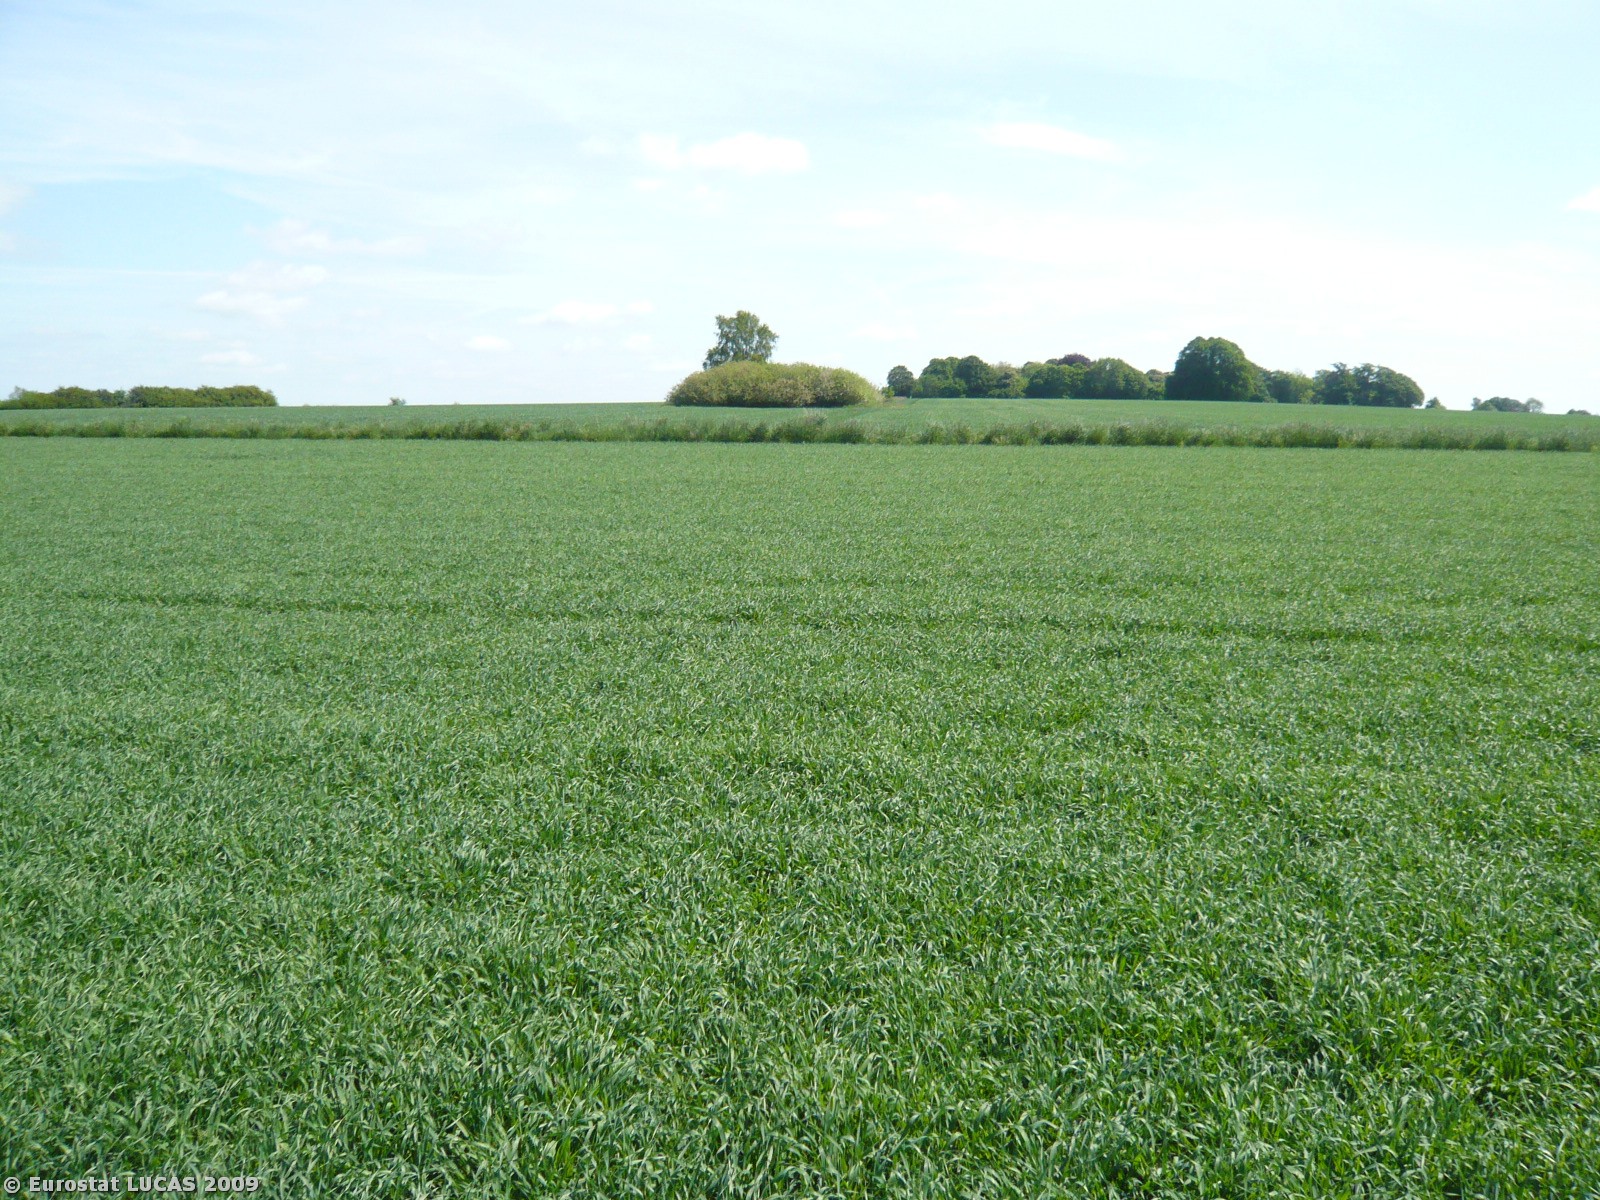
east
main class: Cropland
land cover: Barley
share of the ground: > 75 %
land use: Agriculture (excluding fallow land and kitchen gardens)
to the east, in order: Barley; Grass margins; Common wheat
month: May
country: DK
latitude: 55.3475
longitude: 11.8436
